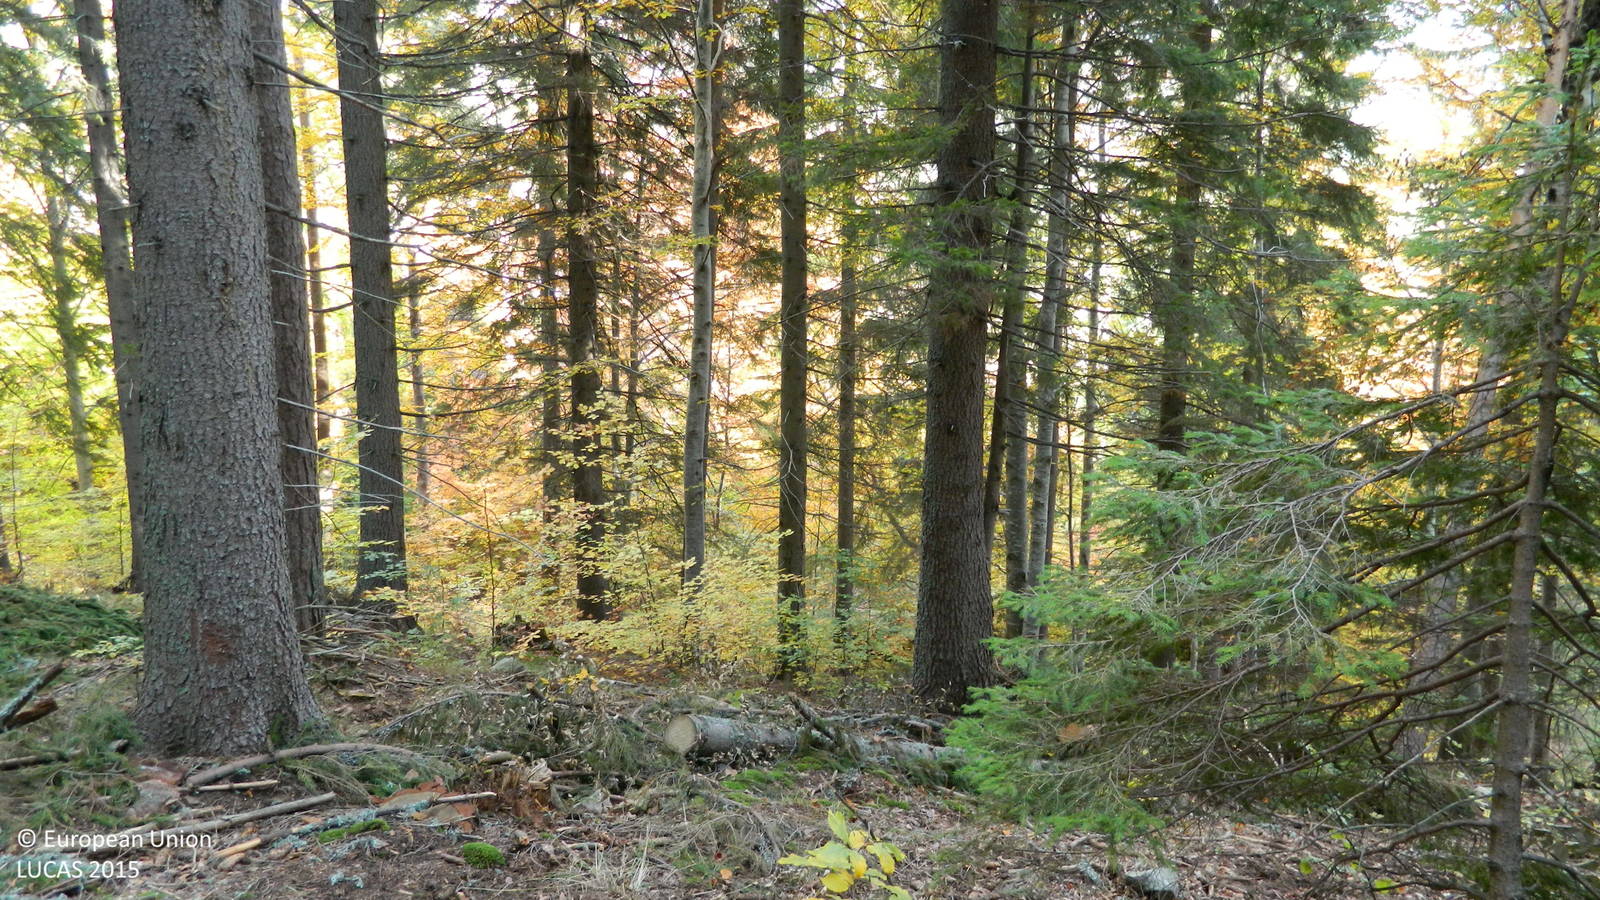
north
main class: Woodland
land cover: Spruce dominated mixed woodland
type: alpine coniferous forest
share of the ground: > 75 %
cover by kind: coniferous forest trees 75 %, broadleaved forest trees 25 %
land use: Forestry
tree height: > 5 m
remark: Clear cut
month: October
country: BG
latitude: 41.6934
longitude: 24.8874
